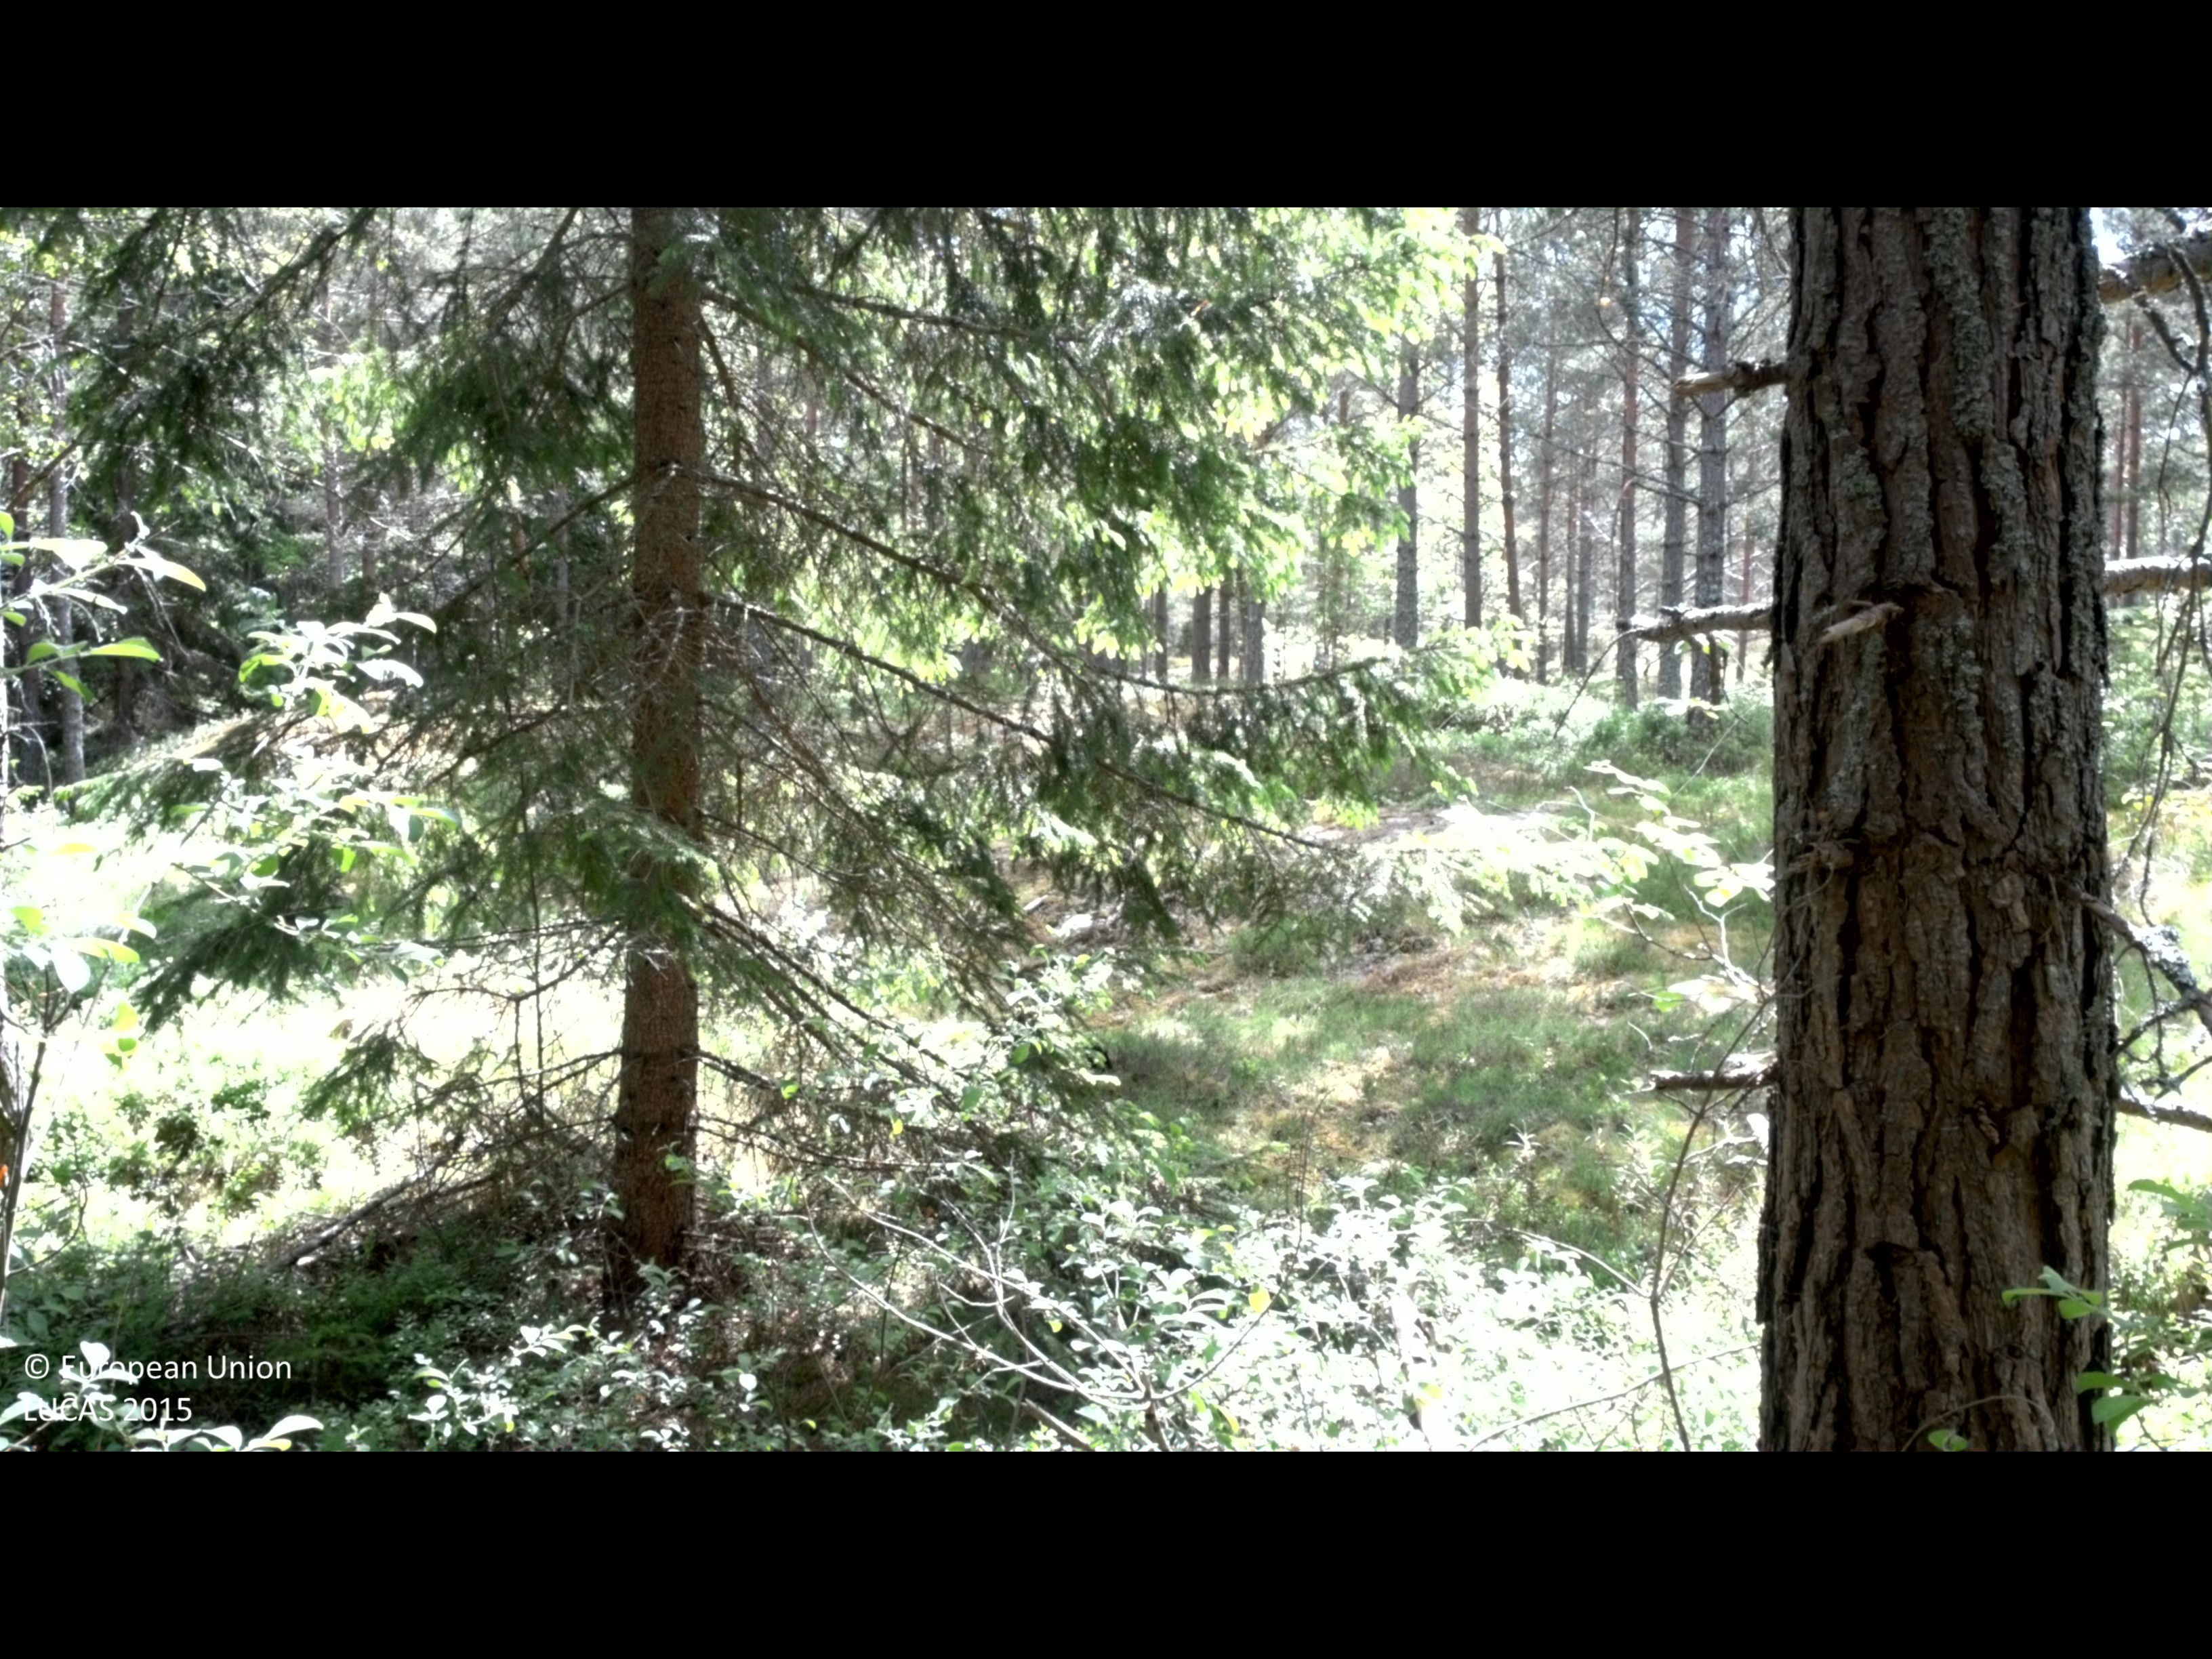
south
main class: Woodland
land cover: Pine dominated mixed woodland
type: boreal forest
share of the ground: > 75 %
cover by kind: coniferous forest trees 45 %, broadleaved forest trees 35 %, shrubs 10 %, lichens and mosses 10 %
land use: Forestry
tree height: > 5 m
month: June
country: SE
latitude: 57.6917
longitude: 16.6926
